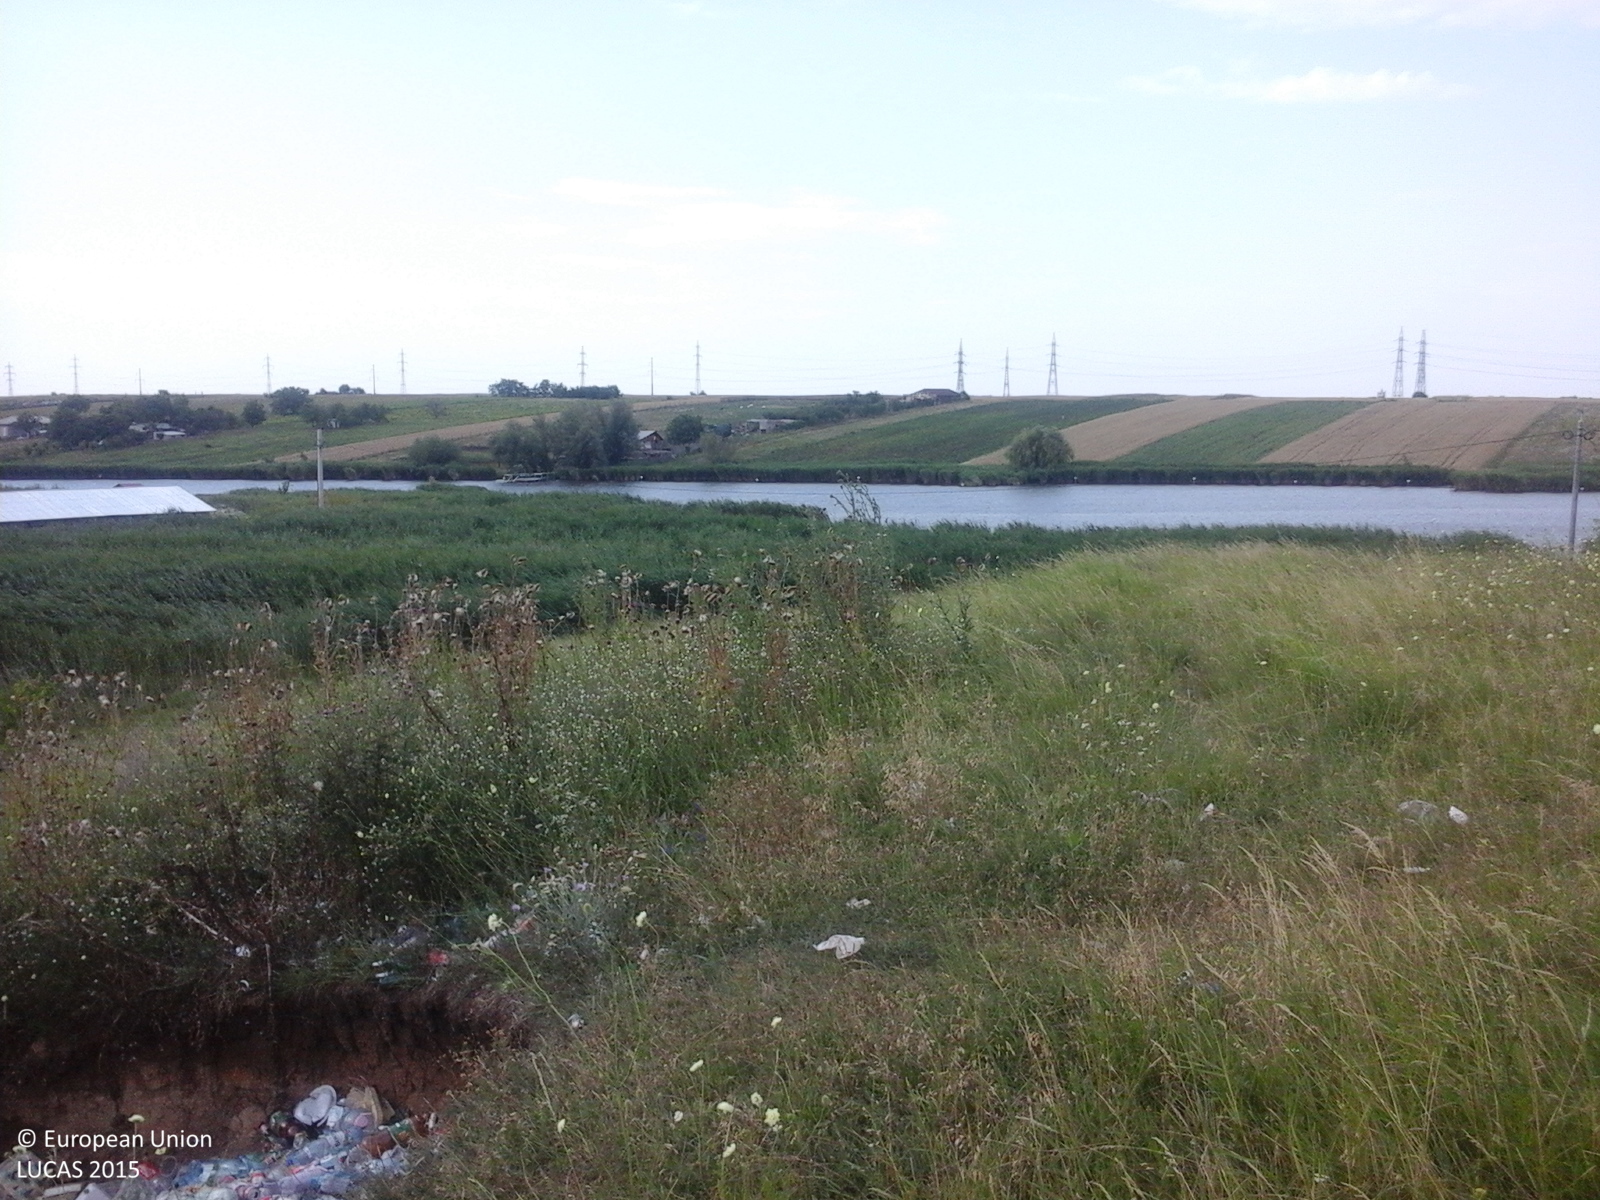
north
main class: Grassland
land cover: Spontaneously vegetated surfaces
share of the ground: > 75 %
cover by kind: herbaceous plants 100 %
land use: Fallow land
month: July
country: RO
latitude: 43.9385
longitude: 25.3184
